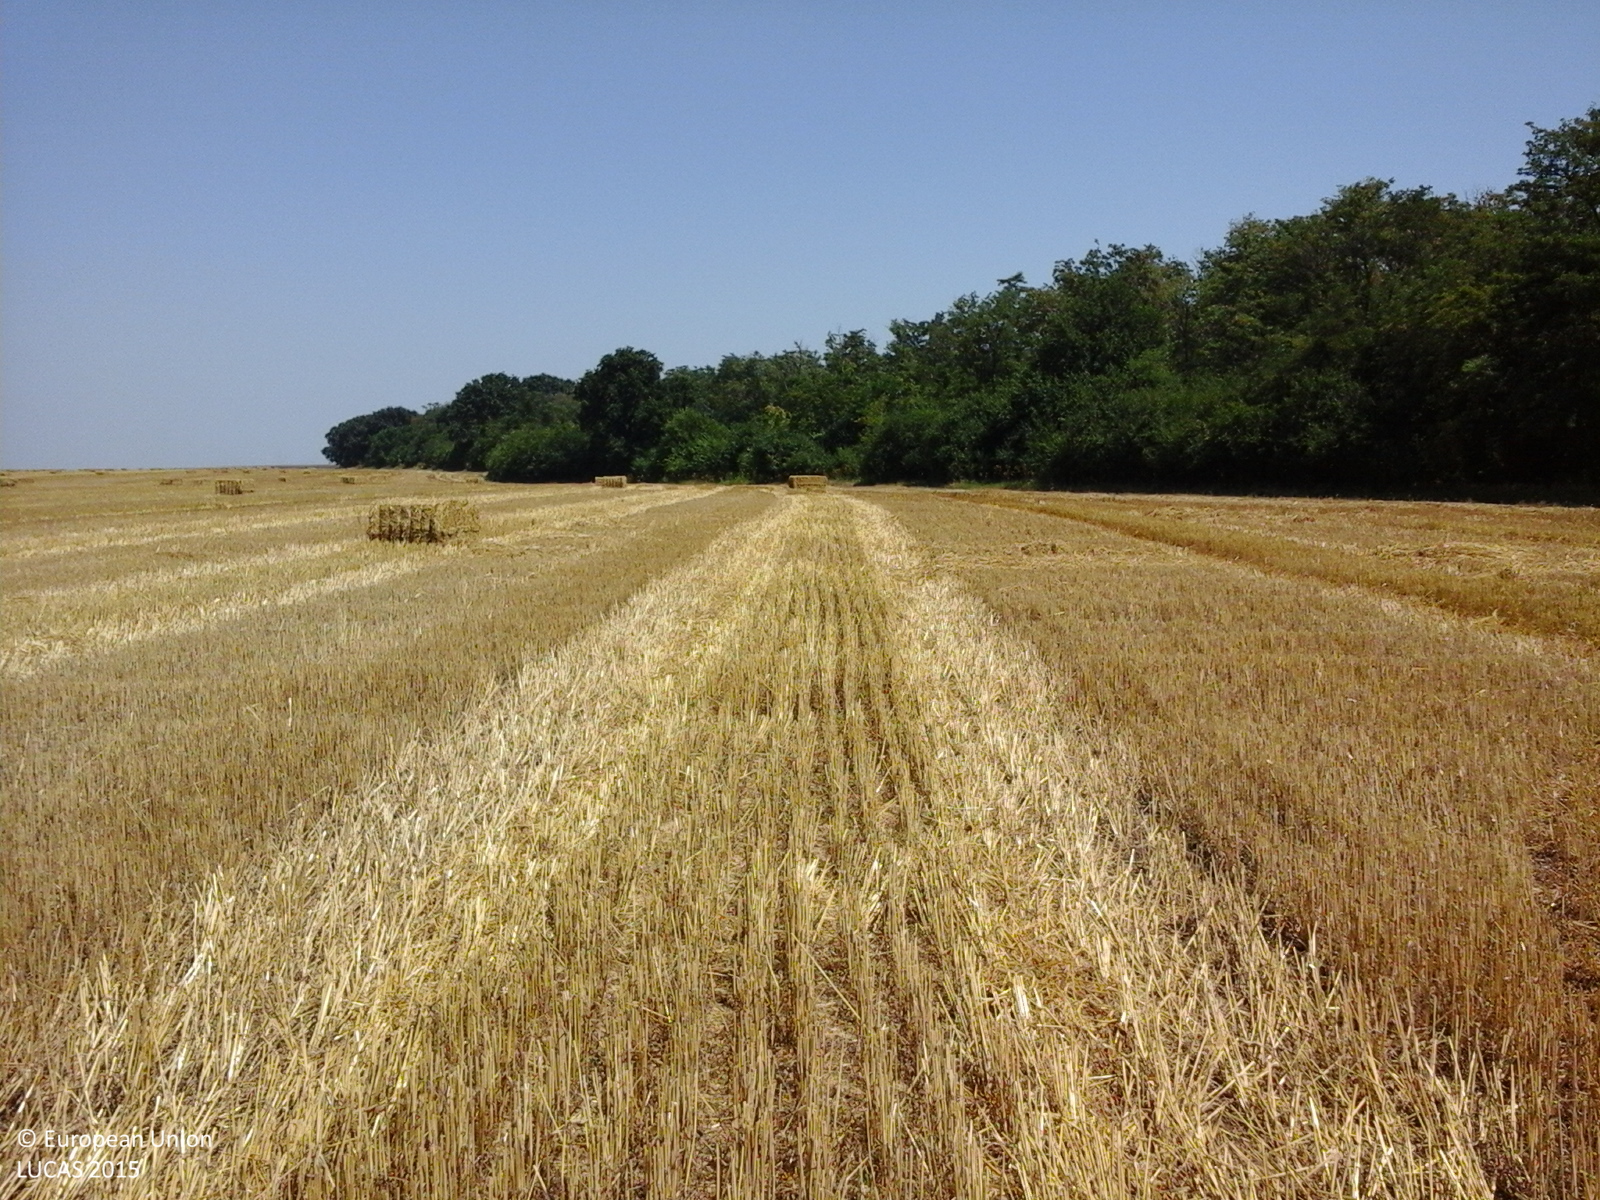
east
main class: Cropland
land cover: Durum wheat
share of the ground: > 75 %
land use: Agriculture (excluding fallow land and kitchen gardens)
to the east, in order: Durum wheat
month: July
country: RO
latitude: 44.2644
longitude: 26.9739
